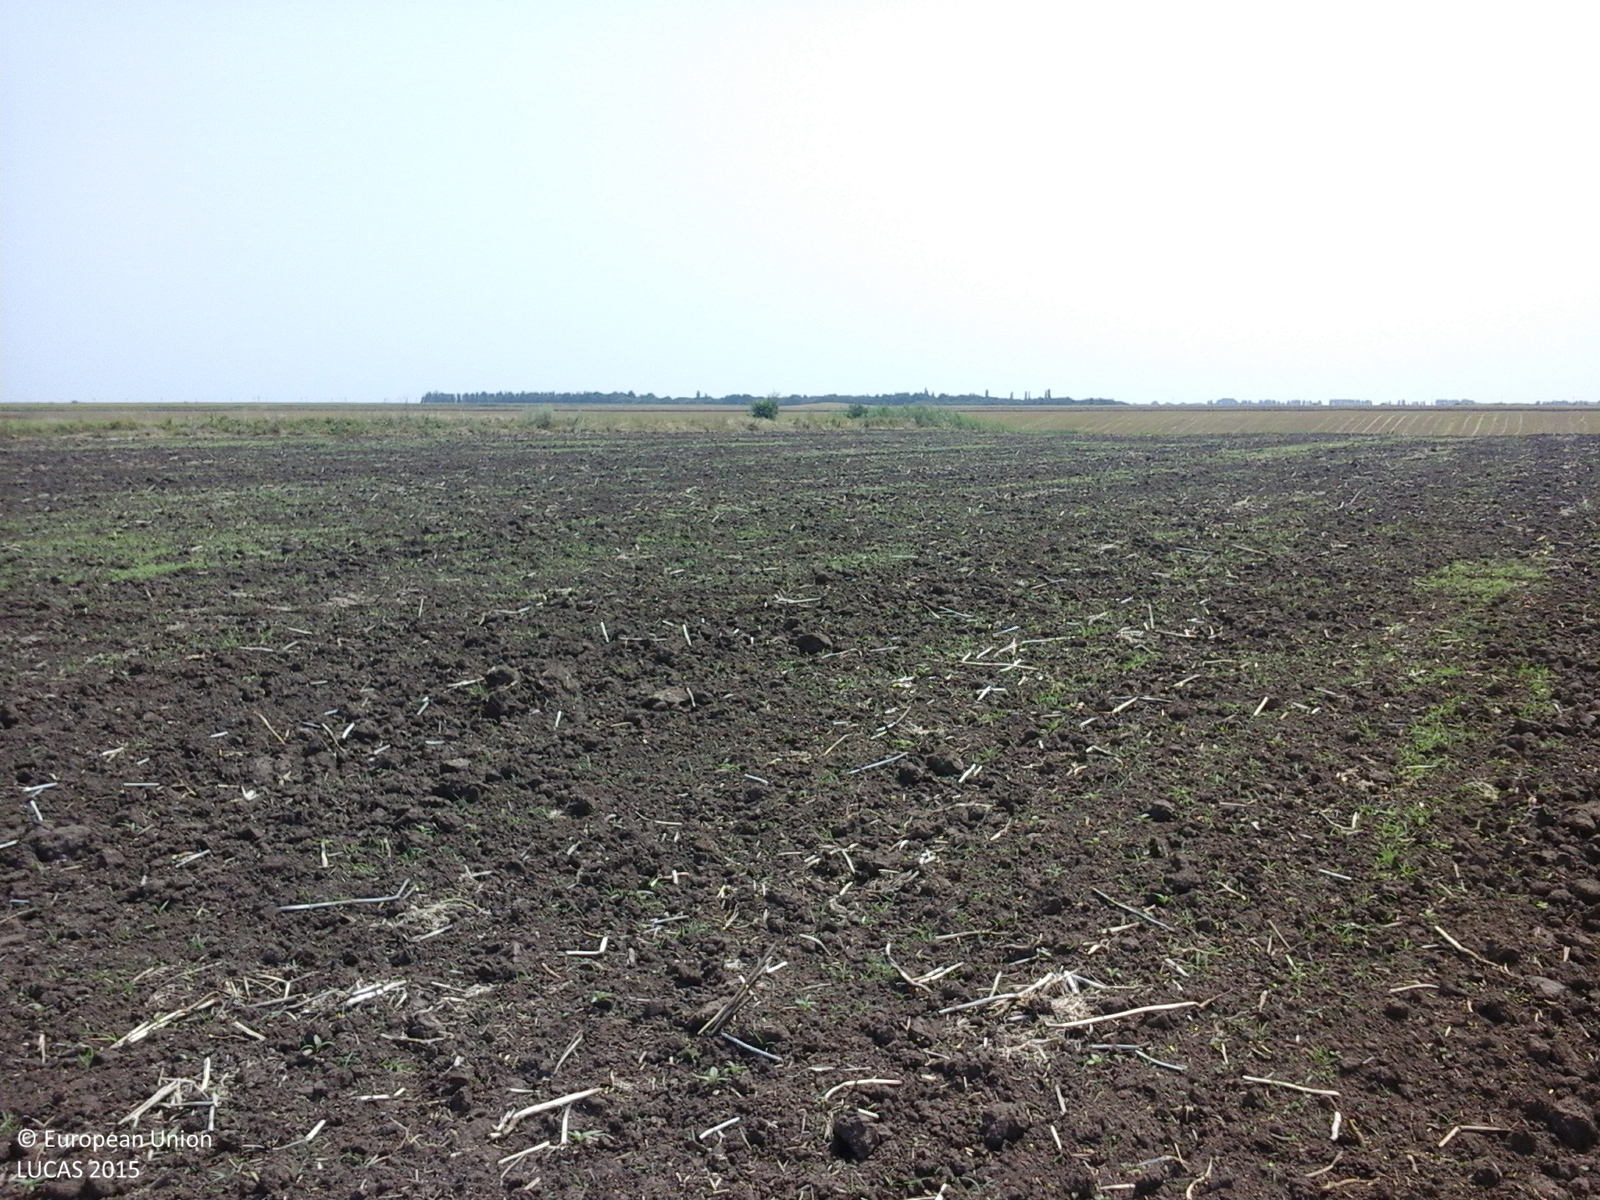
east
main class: Cropland
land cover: Rape and turnip rape
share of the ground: < 10 %
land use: Agriculture (excluding fallow land and kitchen gardens)
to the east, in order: Rape and turnip rape; Ditches and canals; Tracks; Common wheat; Lucerne; Common wheat
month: July
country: RO
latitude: 44.7358
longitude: 26.6780
